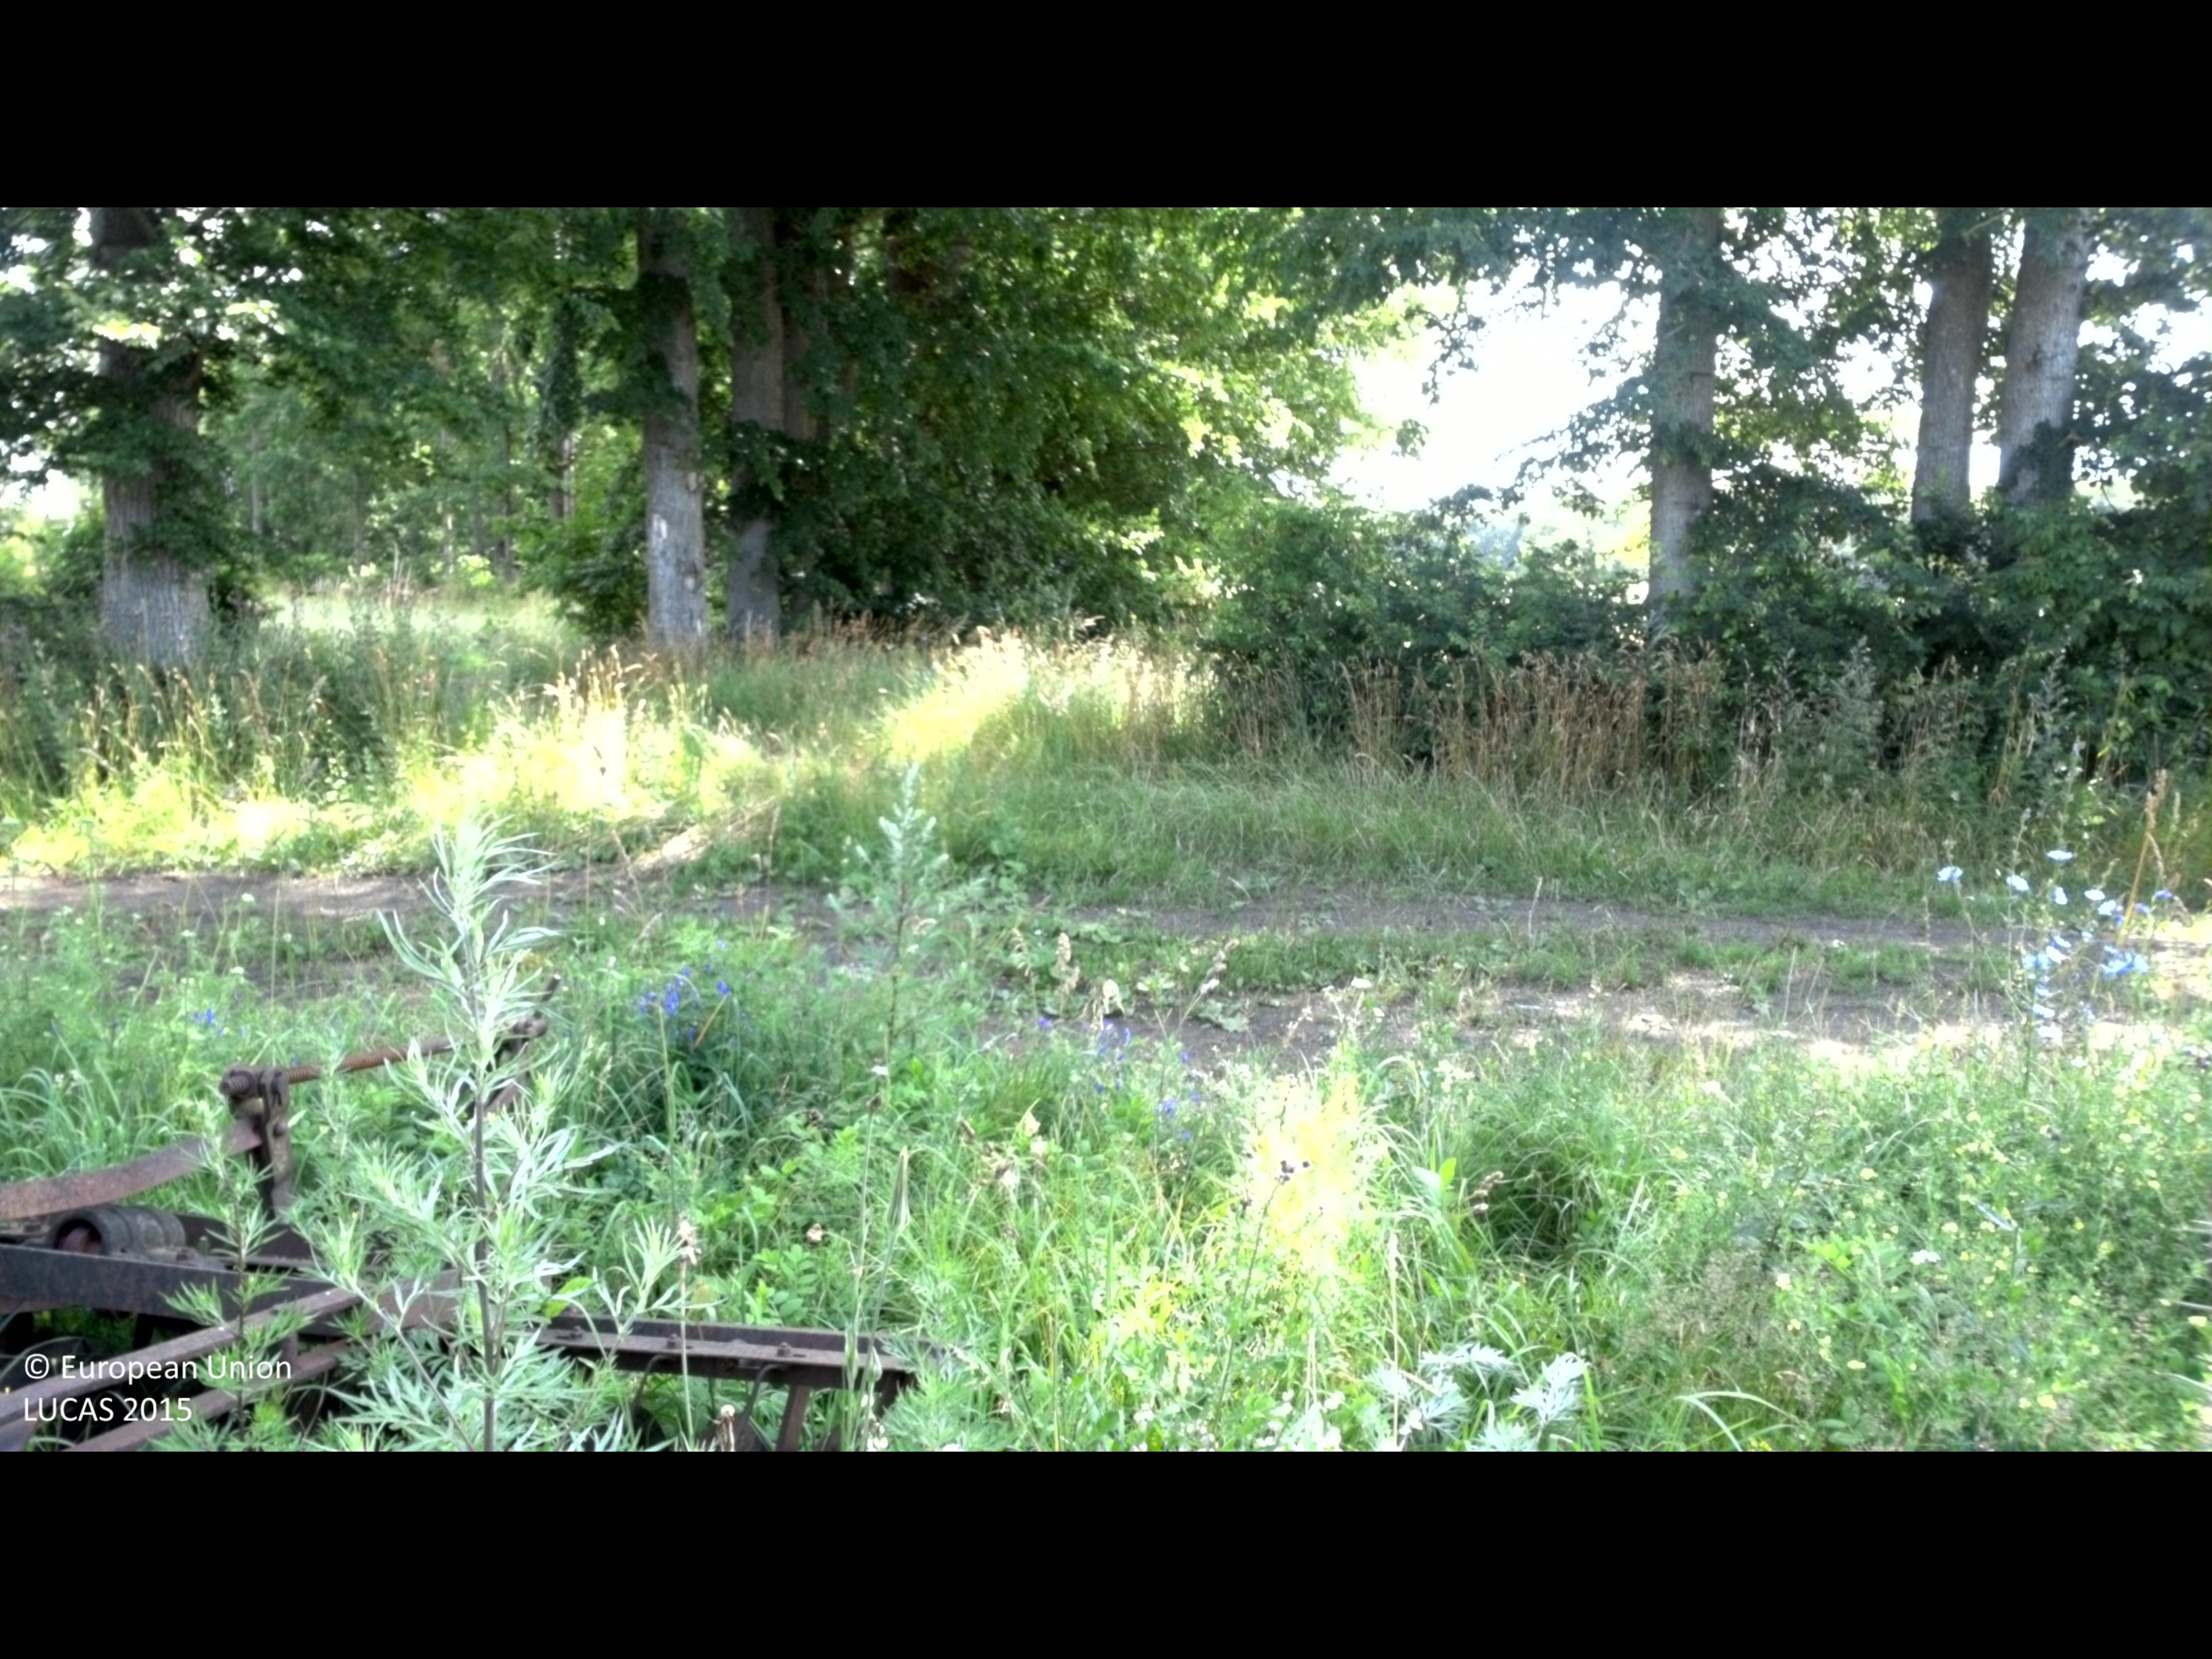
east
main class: Woodland
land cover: Broadleaved woodland
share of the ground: > 75 %
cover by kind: broadleaved forest trees 75 %, shrubs 20 %, herbaceous plants 5 %
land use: Semi-natural and natural areas not in use
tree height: > 5 m
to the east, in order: Ditches and canals; Grass margins; Tracks; Broadleaved woodland; Rape and turnip rape; Dry stone walls; Grass margins; Tracks
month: July
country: SE
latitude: 56.4768
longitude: 16.4471
